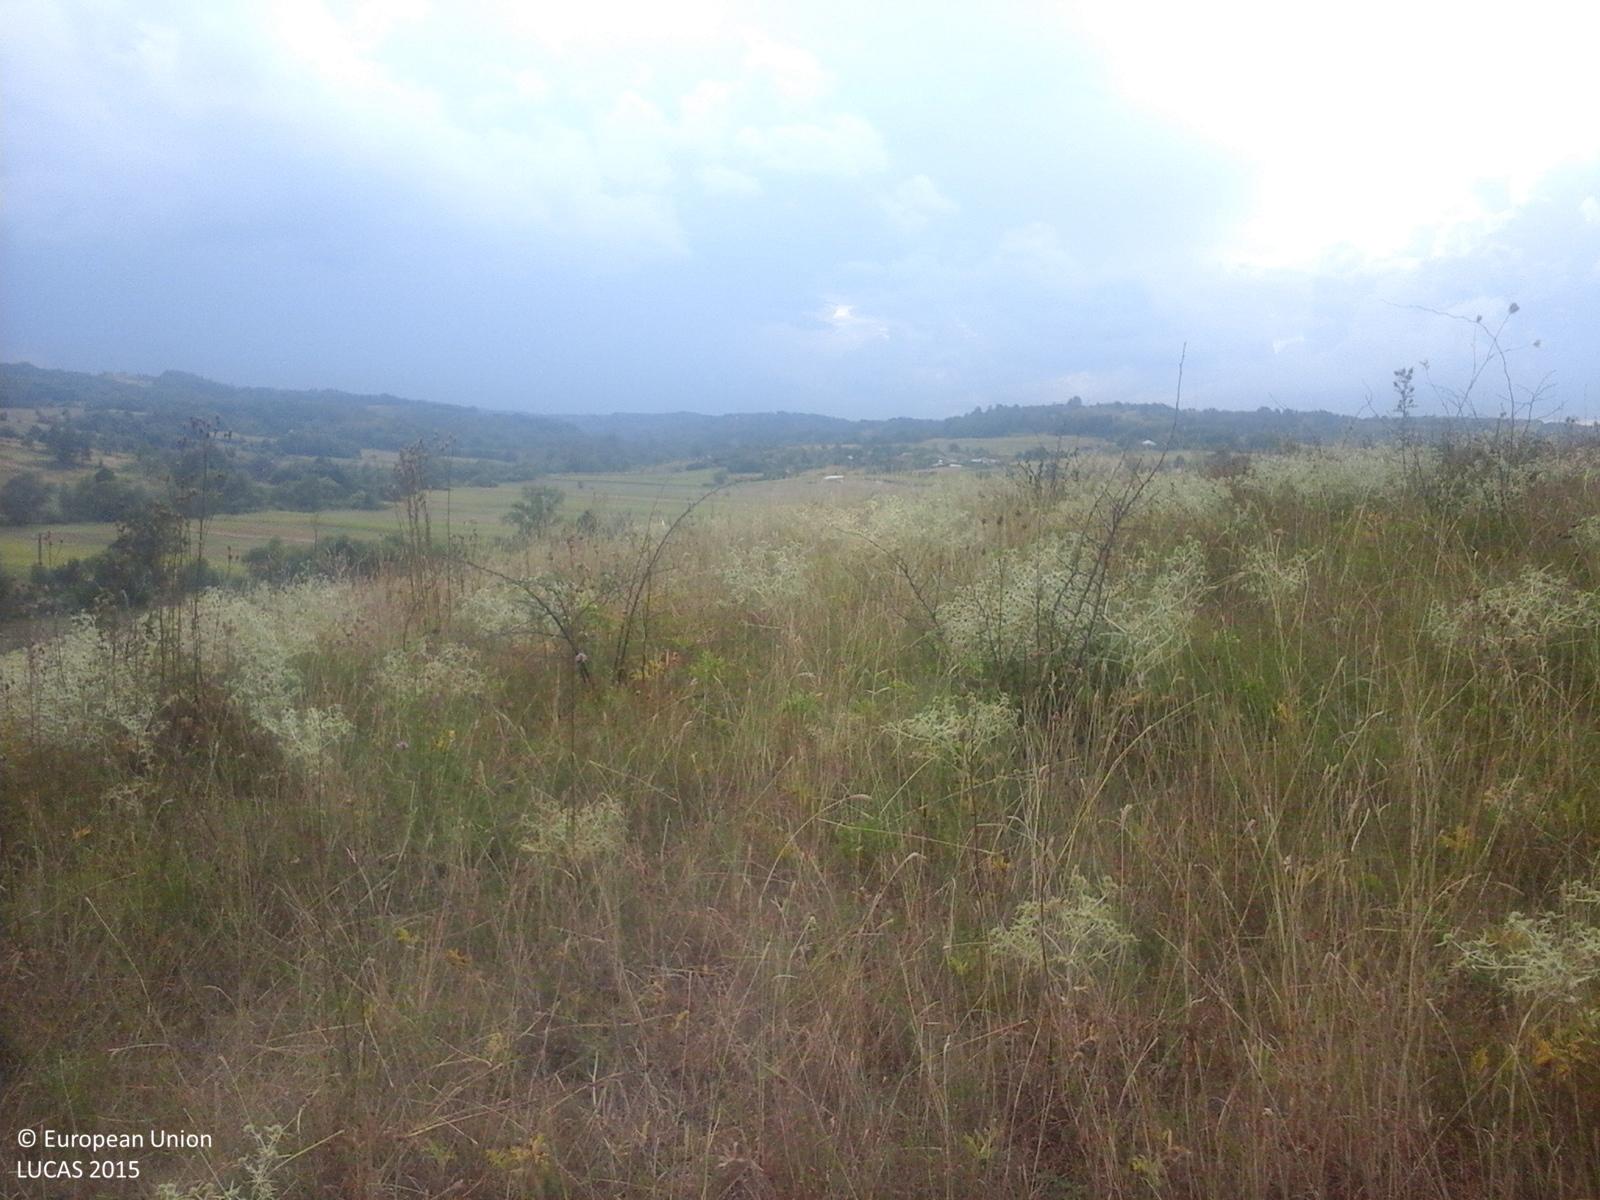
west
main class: Grassland
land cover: Spontaneously vegetated surfaces
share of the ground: > 75 %
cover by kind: herbaceous plants 100 %
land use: Fallow land
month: August
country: RO
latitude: 44.8000
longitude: 22.9032
